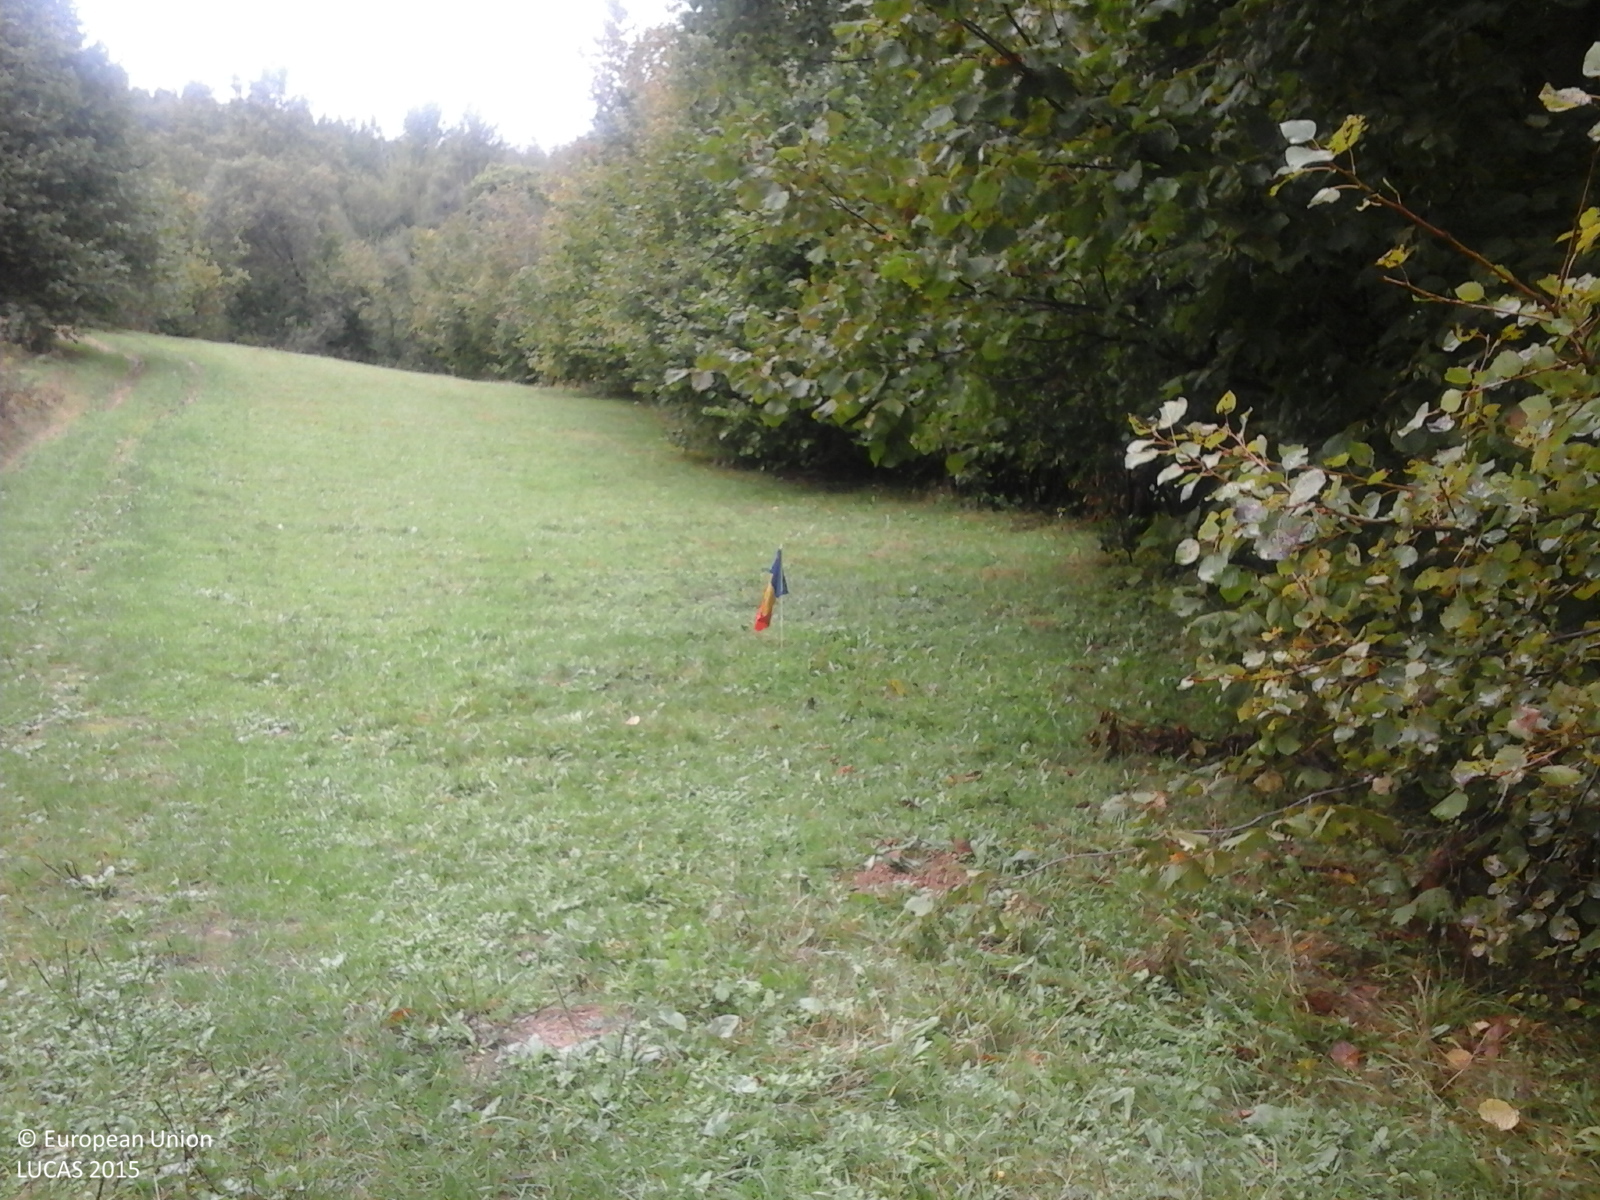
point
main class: Grassland
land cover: Grassland with sparse tree/shrub cover
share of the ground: > 75 %
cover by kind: herbaceous plants 85 %, shrubs 10 %, broadleaved forest trees 5 %
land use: Agriculture (excluding fallow land and kitchen gardens)
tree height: < 5 m
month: September
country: RO
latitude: 45.8023
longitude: 23.7709
